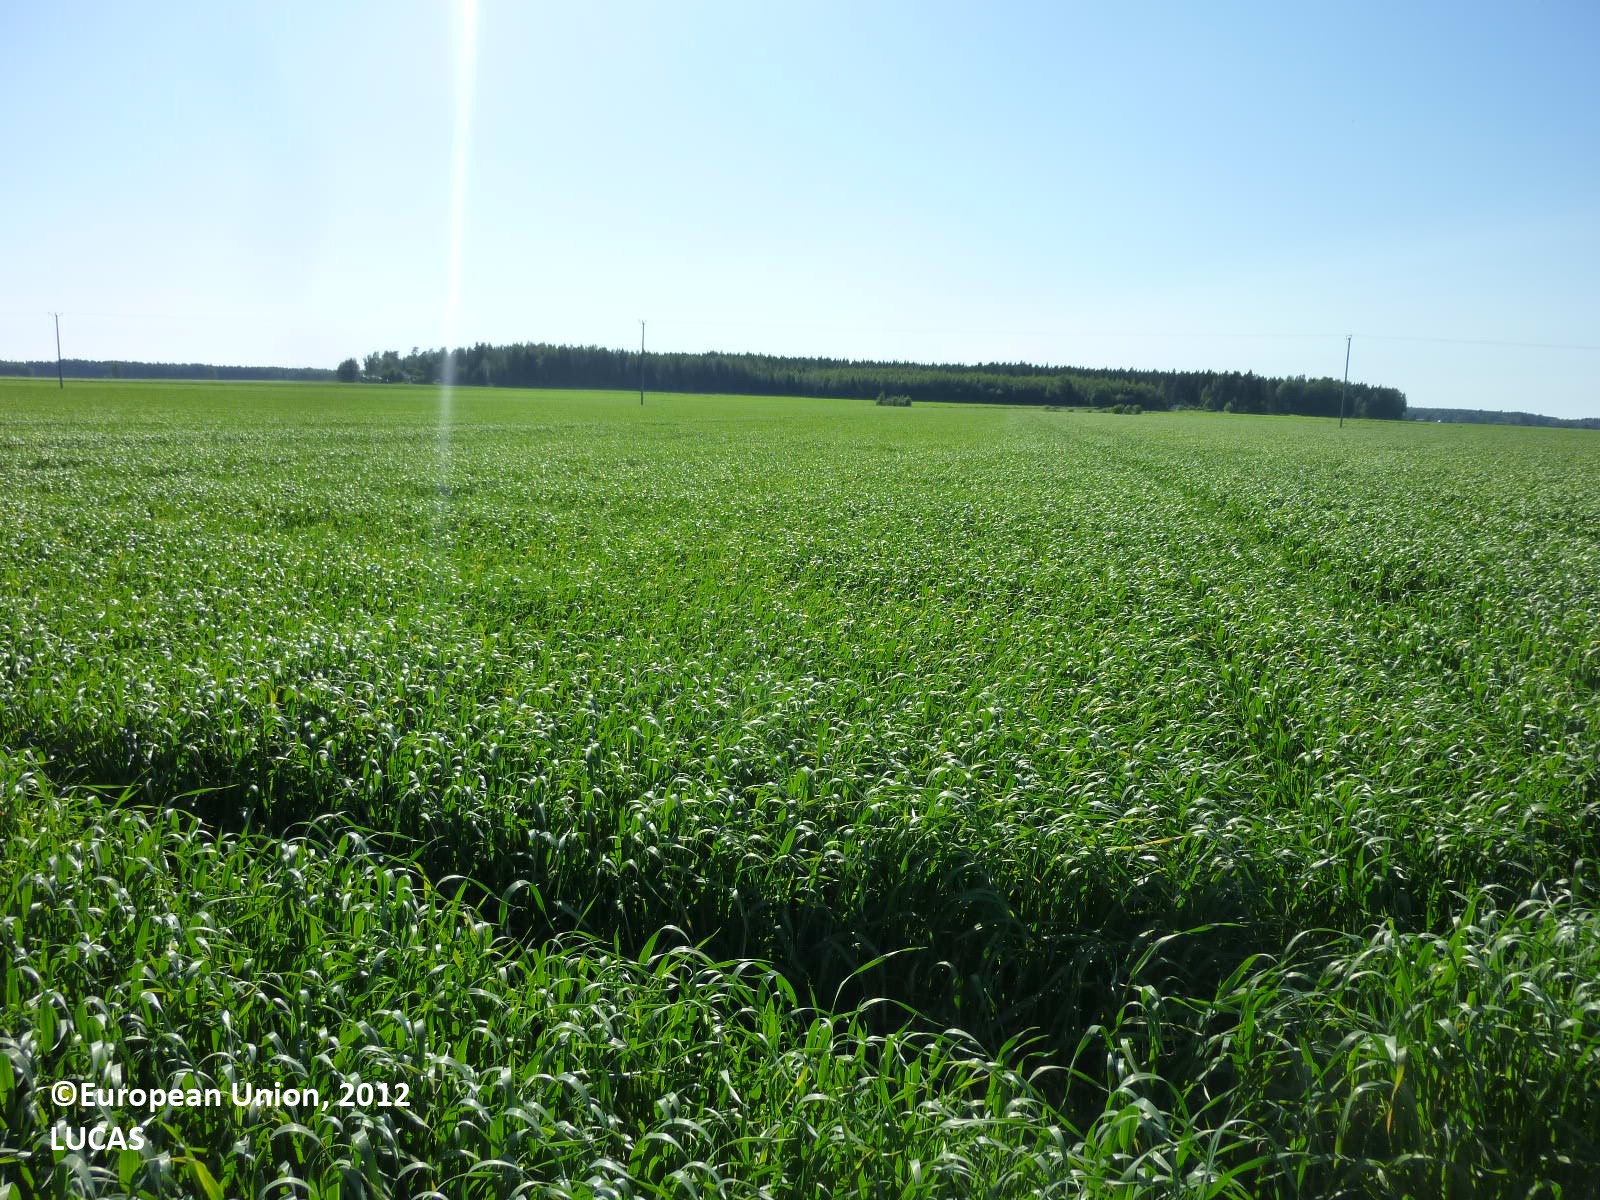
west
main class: Cropland
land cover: Oats
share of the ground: > 75 %
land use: Agriculture (excluding fallow land and kitchen gardens)
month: July
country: FI
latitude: 61.3271
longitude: 21.9963
